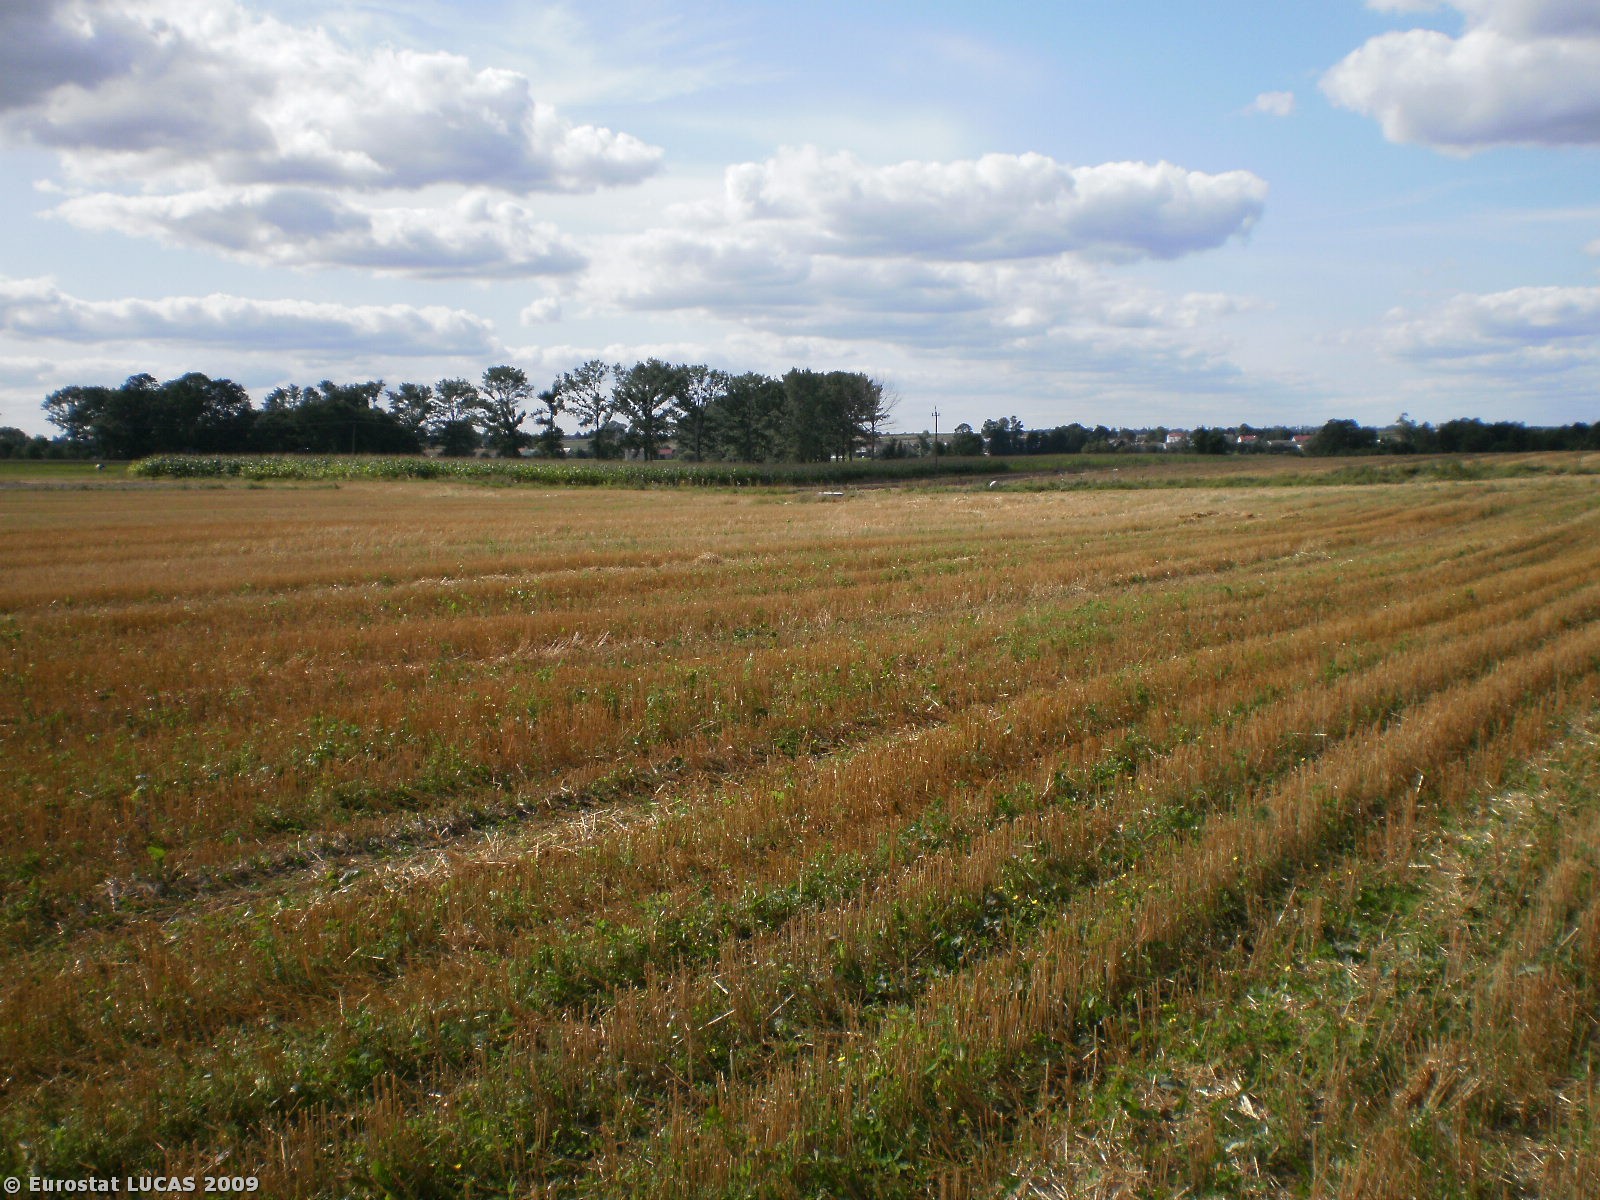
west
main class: Cropland
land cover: Maize
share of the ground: > 75 %
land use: Agriculture (excluding fallow land and kitchen gardens)
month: August
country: PL
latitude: 52.5486
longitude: 22.3481
